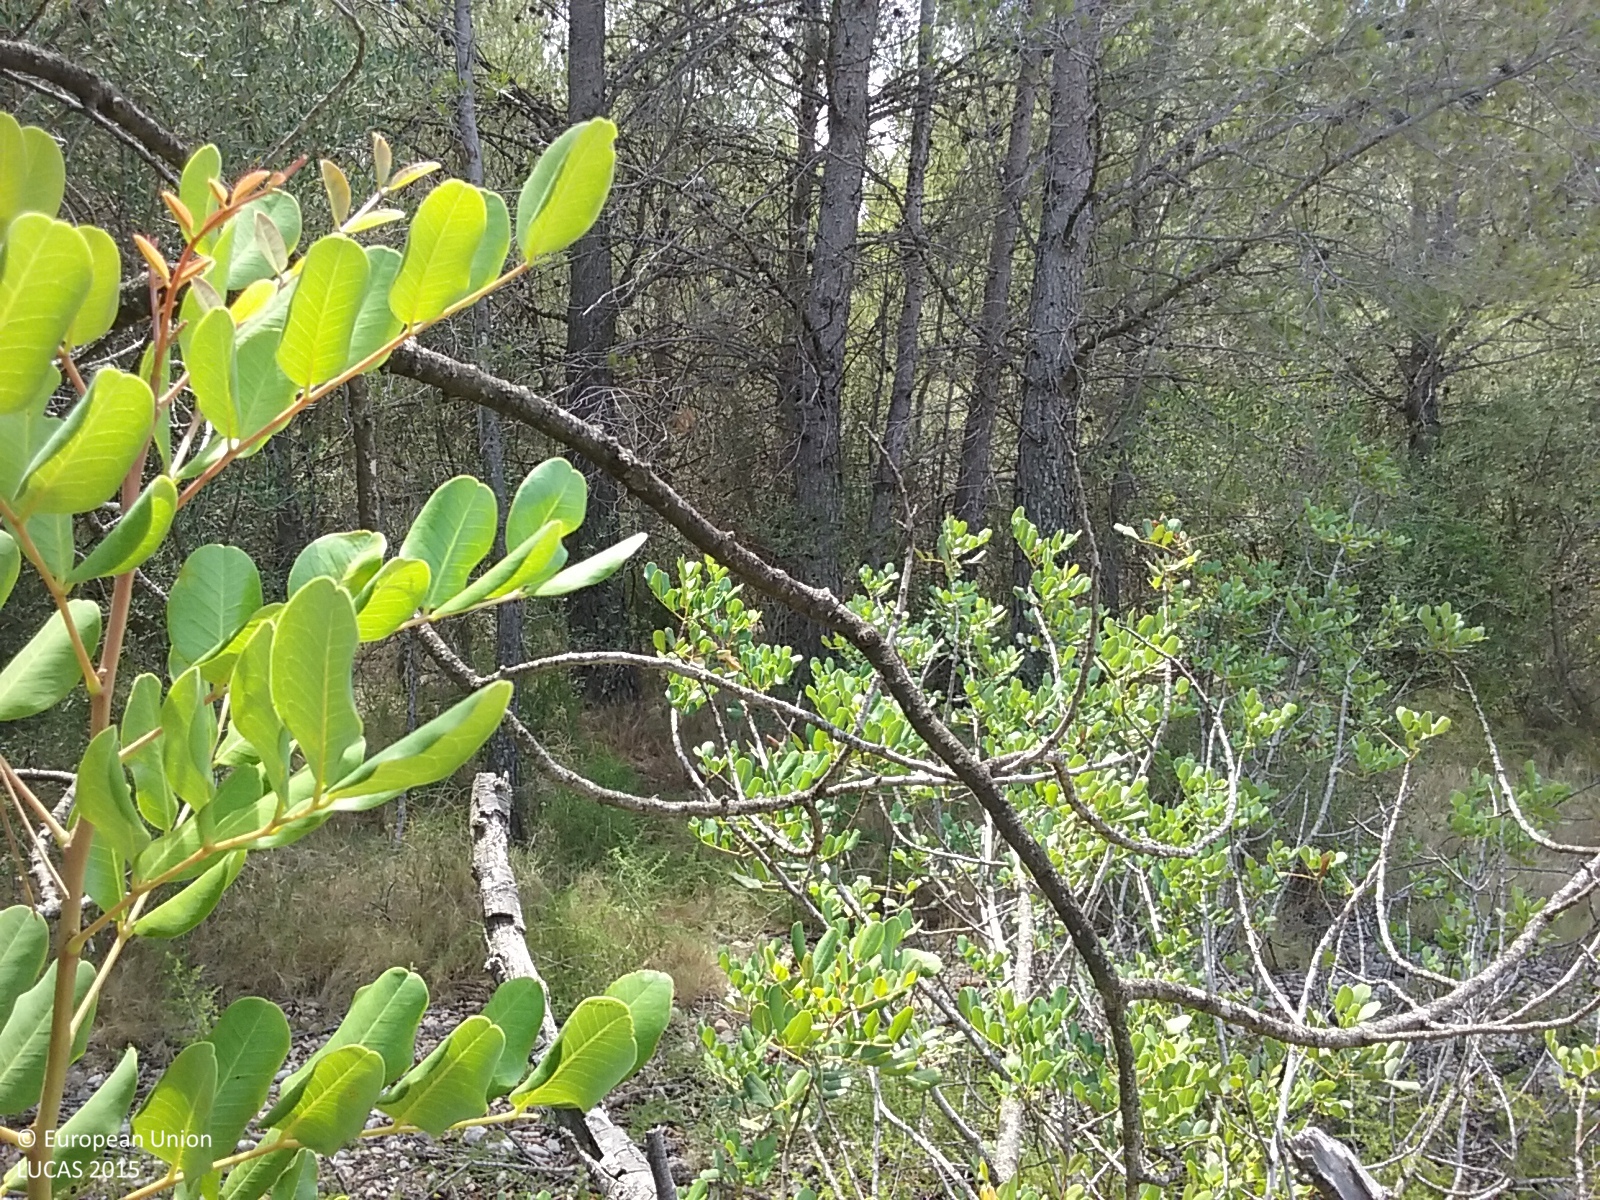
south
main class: Cropland
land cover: Permanent industrial crops
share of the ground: 10 - 25 %
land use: Abandoned areas
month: July
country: ES
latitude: 40.2570
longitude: -0.0799
